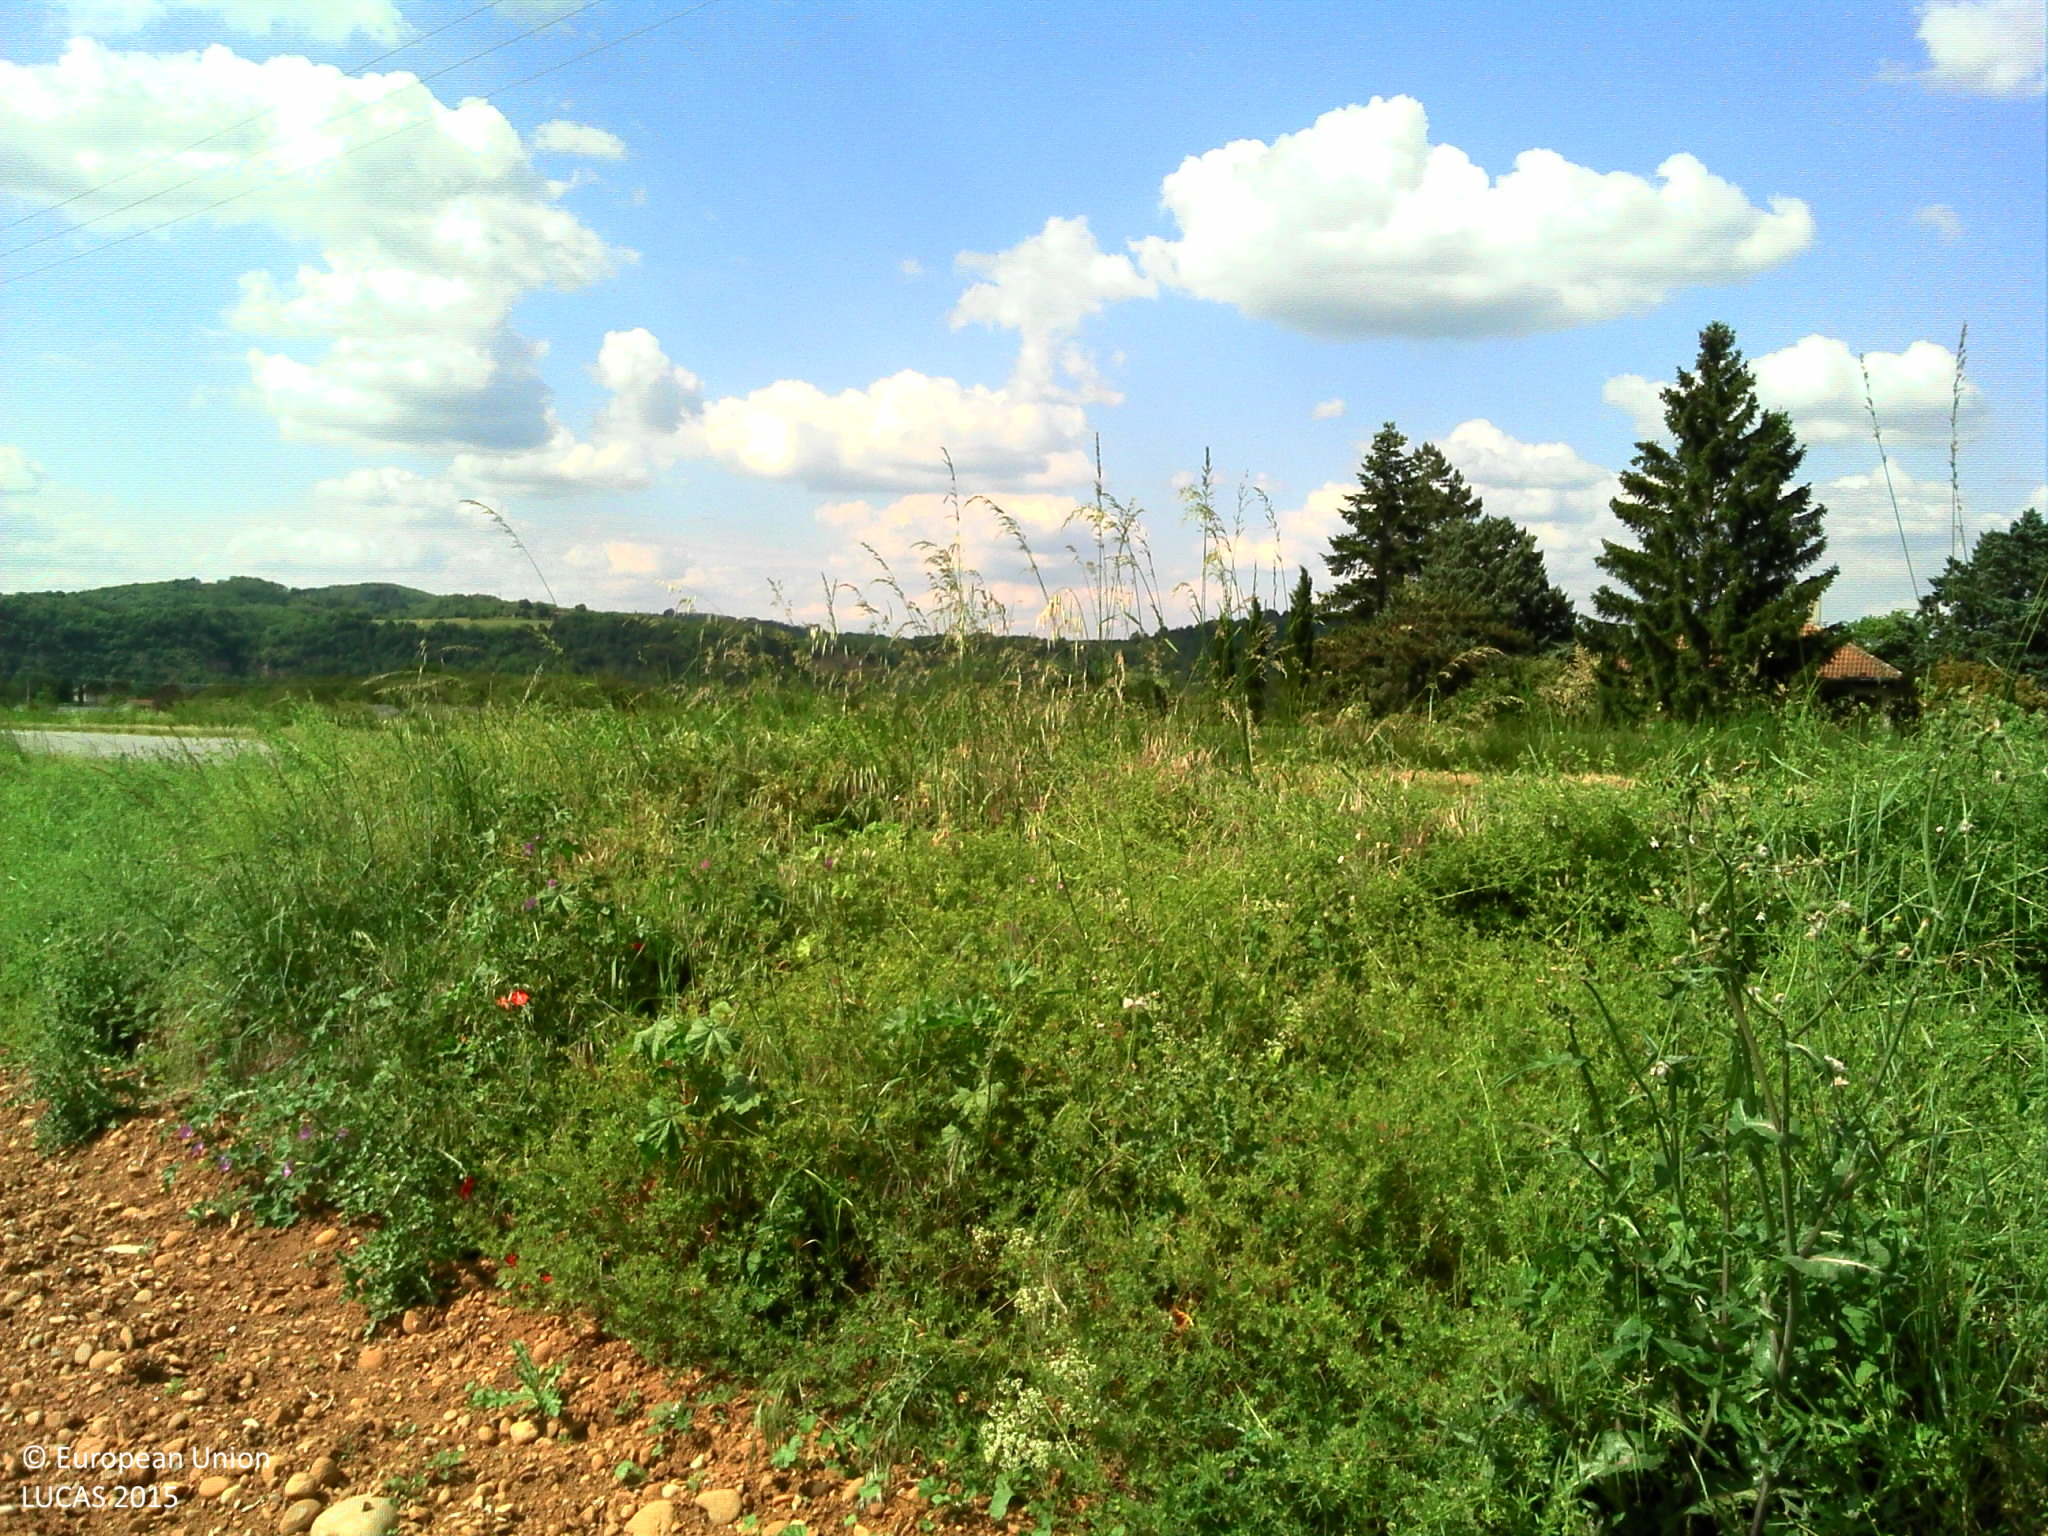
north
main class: Cropland
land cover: Maize
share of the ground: 10 - 25 %
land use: Agriculture (excluding fallow land and kitchen gardens)
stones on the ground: > 50 %
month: May
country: FR
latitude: 45.0699
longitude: 5.1917
